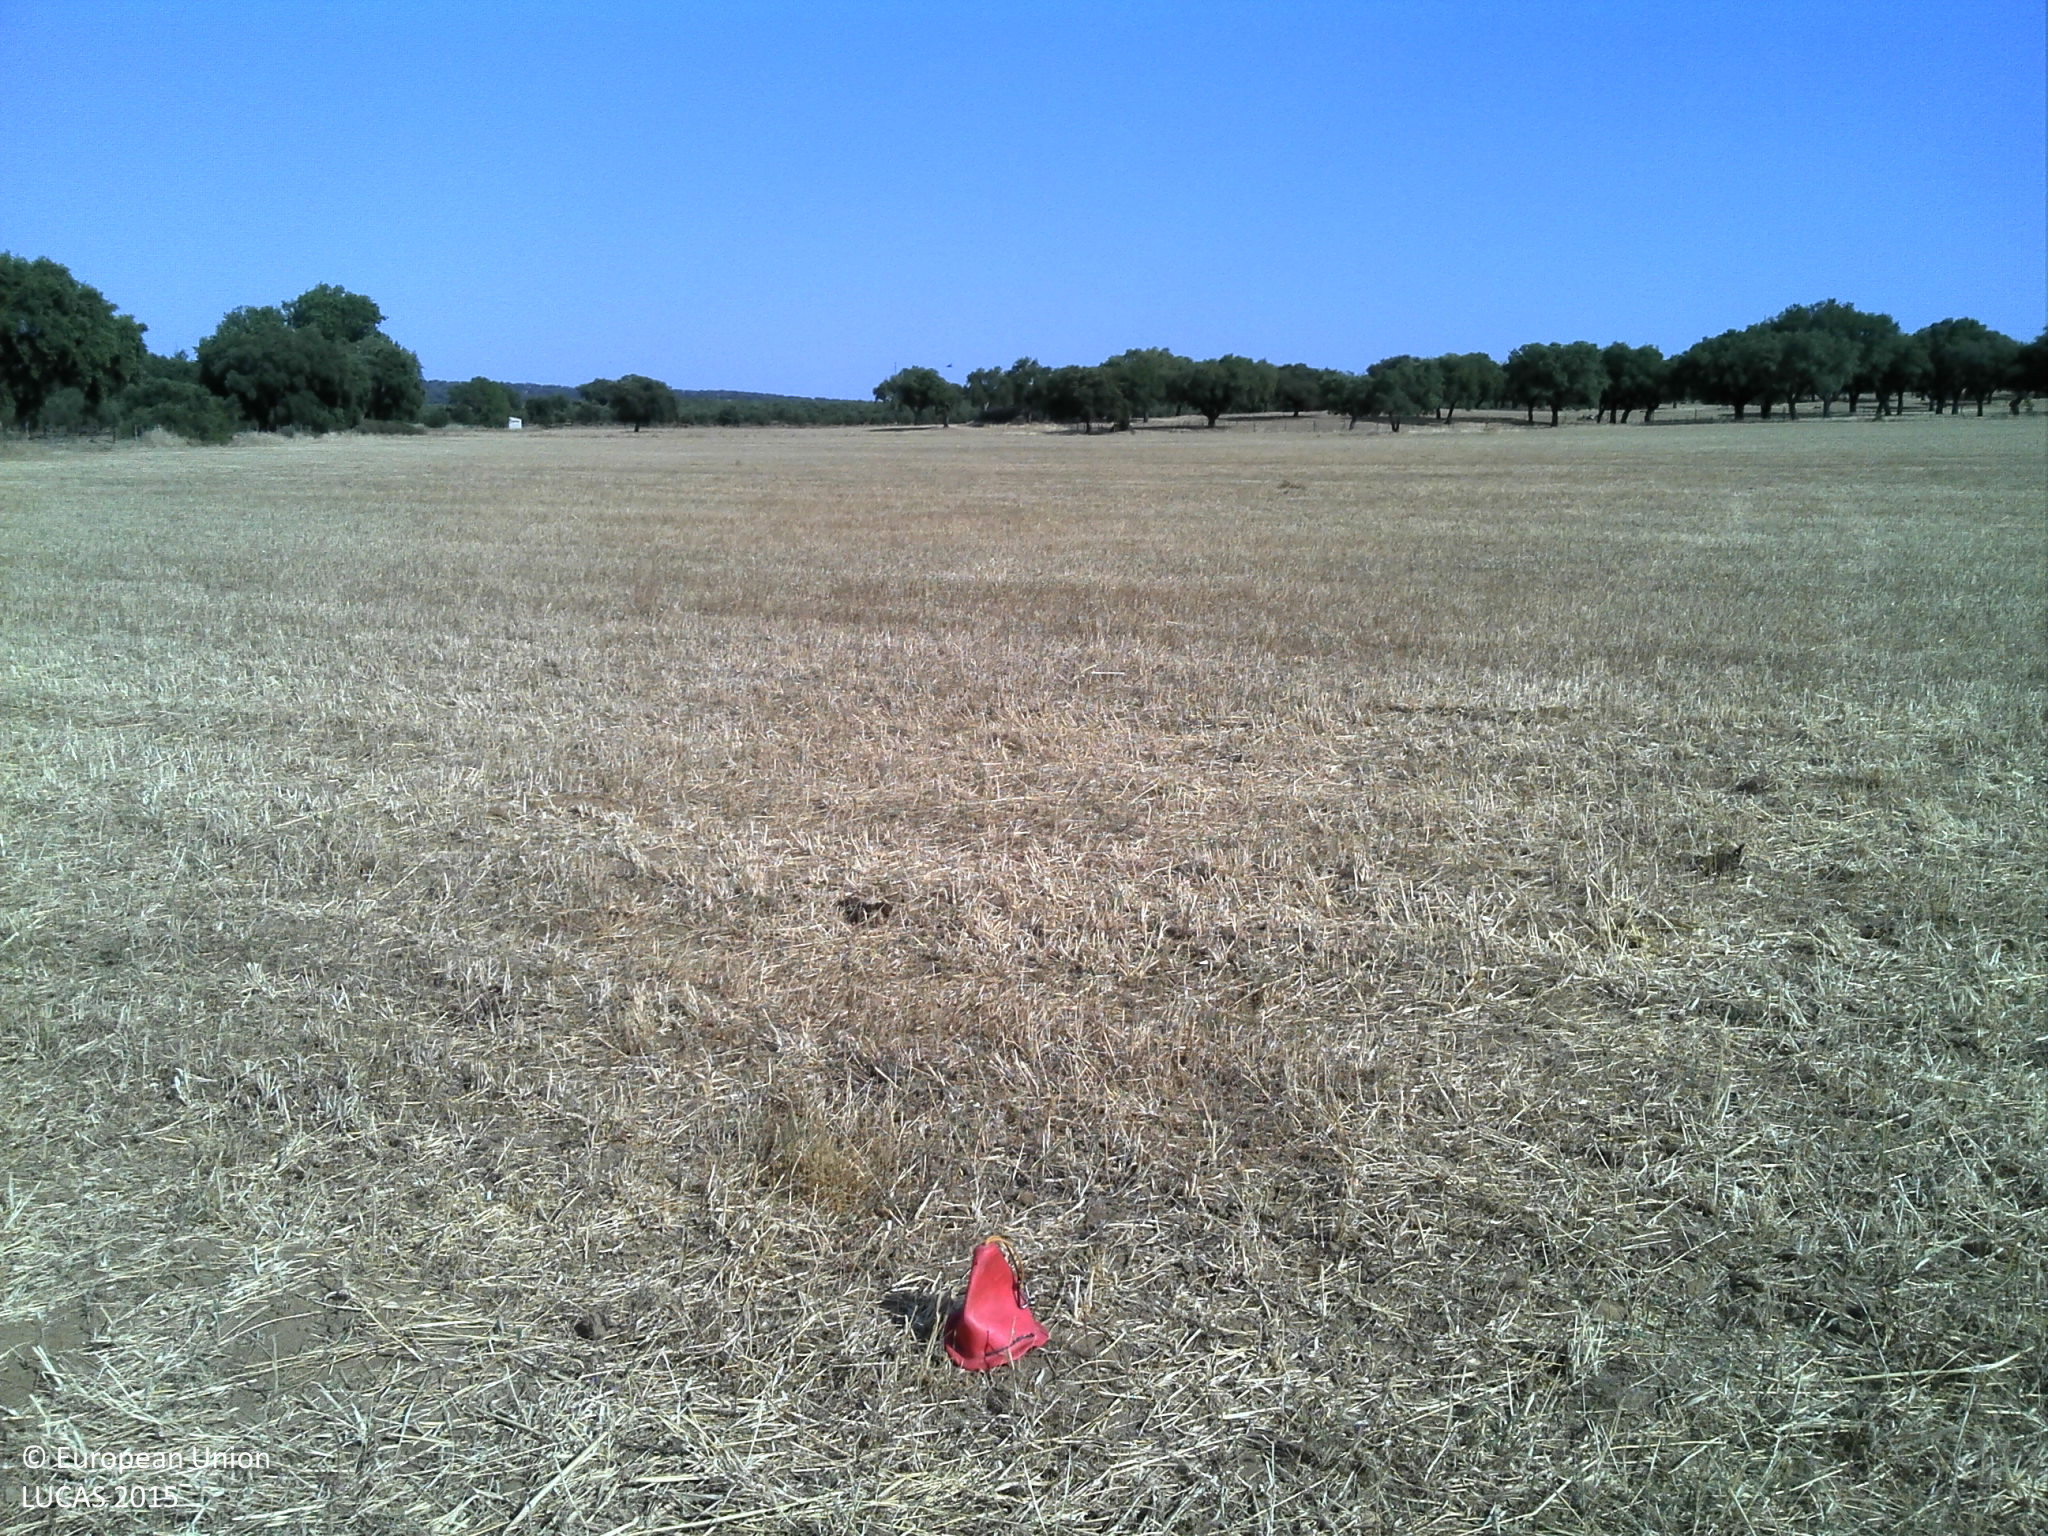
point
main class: Cropland
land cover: Oats
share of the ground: < 10 %
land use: Agriculture (excluding fallow land and kitchen gardens)
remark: Harvested field
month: June
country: PT
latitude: 38.6895
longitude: -7.8485
